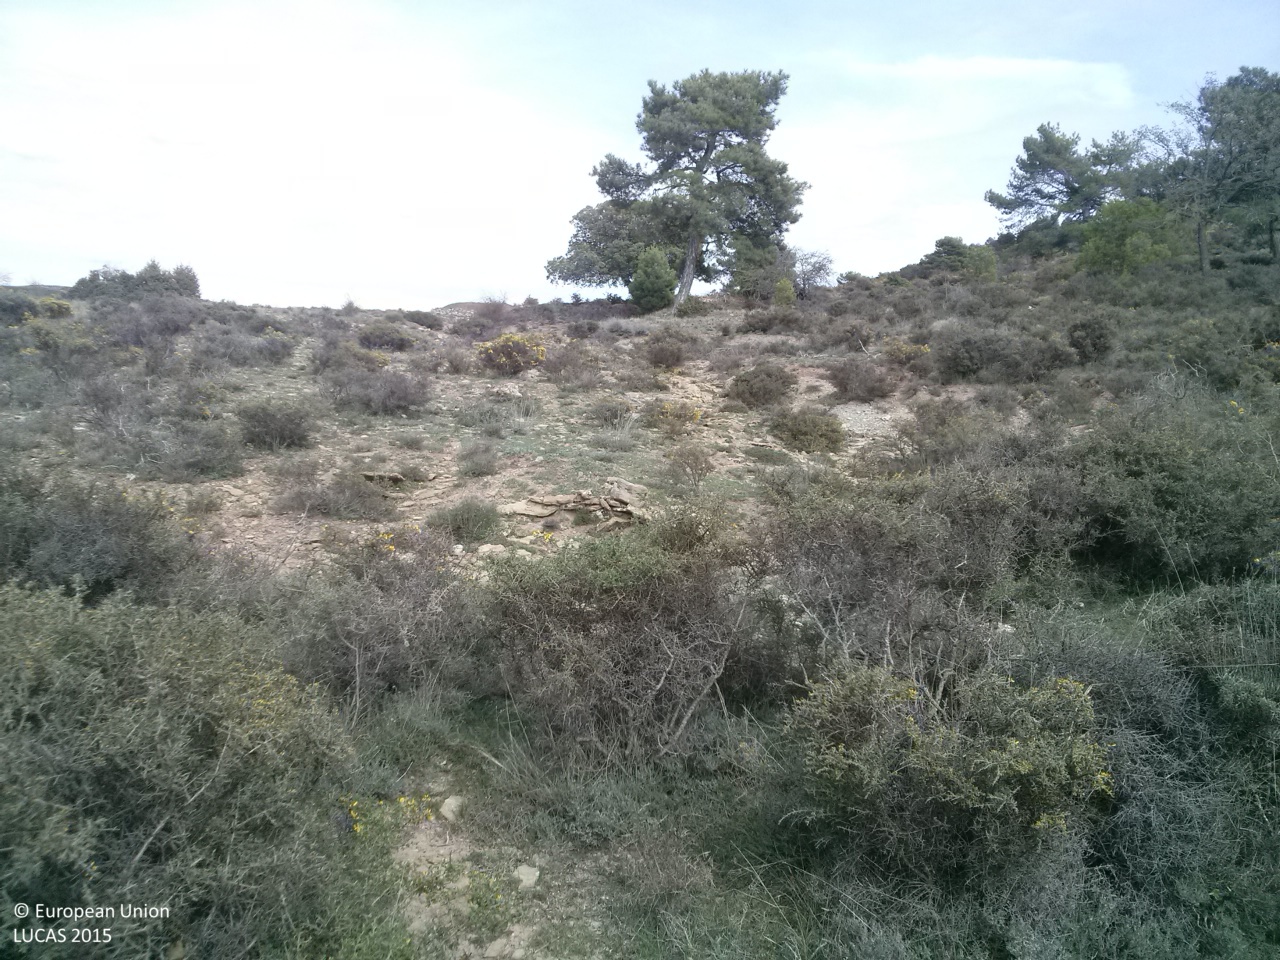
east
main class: Shrubland
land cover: Shrubland without tree cover
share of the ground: 50 - 75 %
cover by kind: shrubs 60 %, herbaceous plants 30 %, unconsolidated bare surface 10 %
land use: Agriculture (excluding fallow land and kitchen gardens)
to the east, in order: Shrubland without tree cover; Shrubland with sparse tree cover; Shrubland without tree cover; Grassland without tree/shrub cover
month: April
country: ES
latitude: 40.1237
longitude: -1.7594
